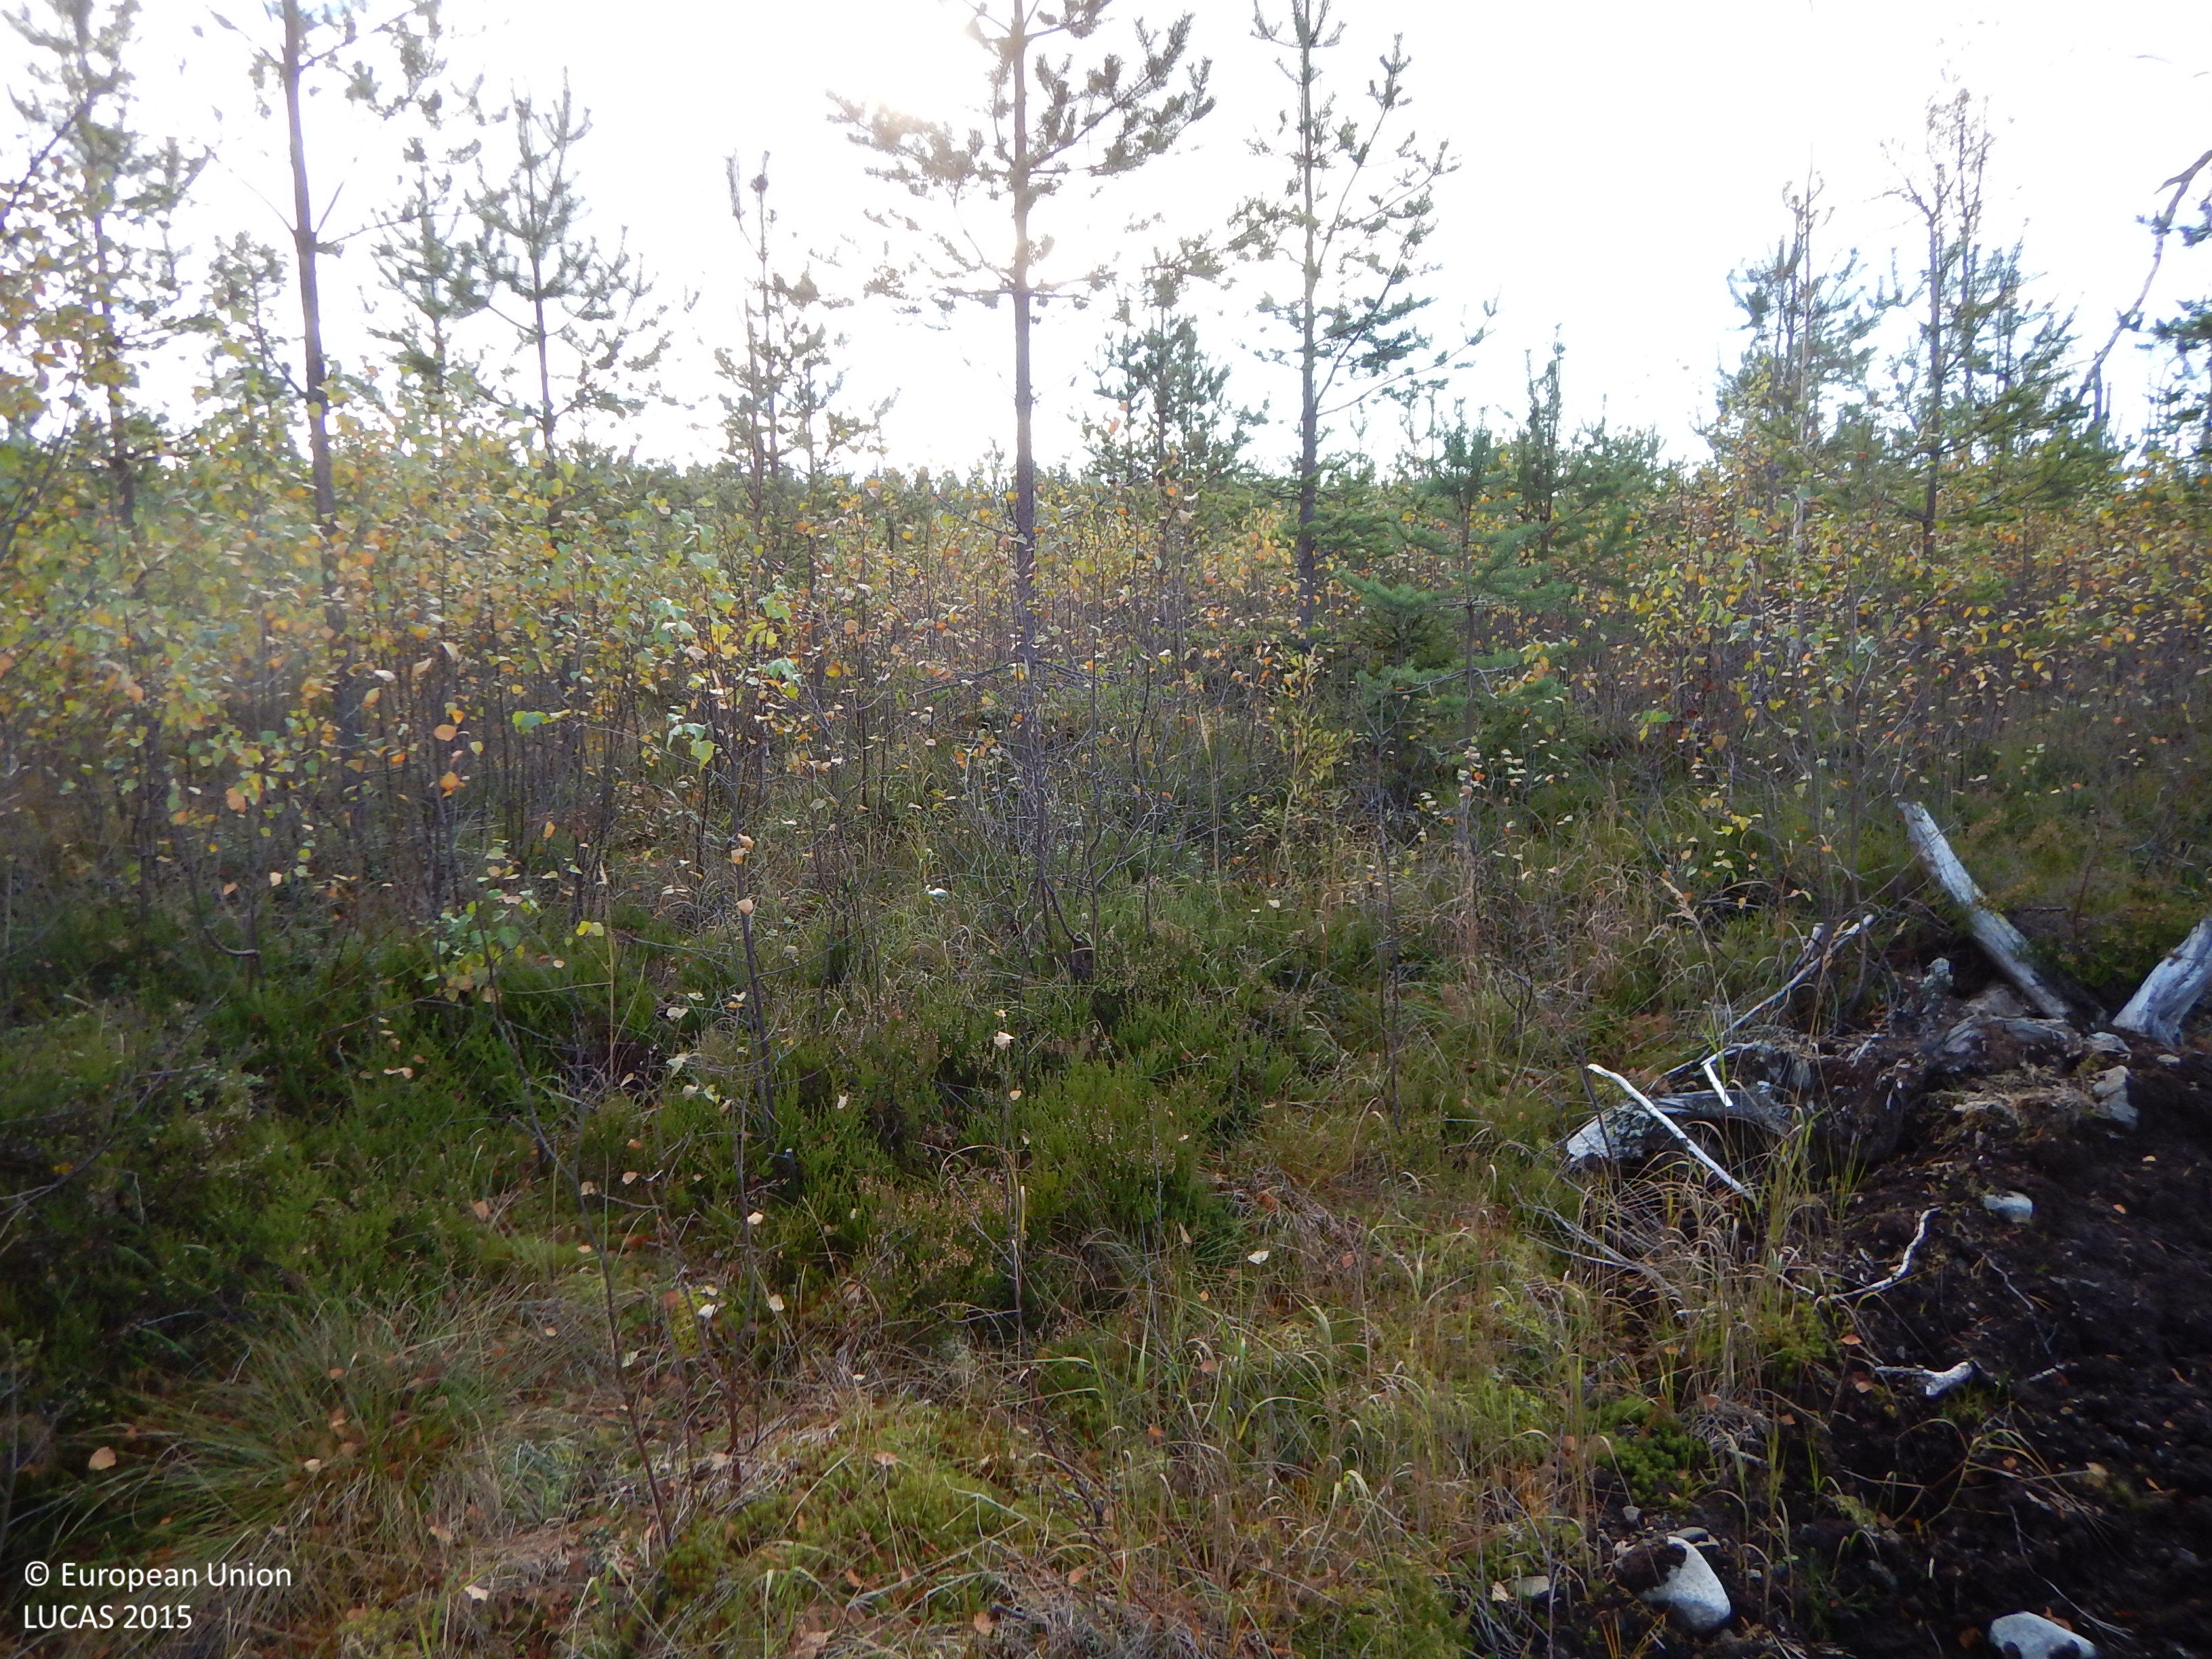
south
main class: Woodland
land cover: Other mixed woodland
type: boreal forest
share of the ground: 50 - 75 %
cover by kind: coniferous forest trees 45 %, broadleaved forest trees 25 %, herbaceous plants 15 %, shrubs 10 %, lichens and mosses 5 %
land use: Forestry
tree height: < 5 m
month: October
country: SE
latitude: 64.9822
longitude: 21.0174
